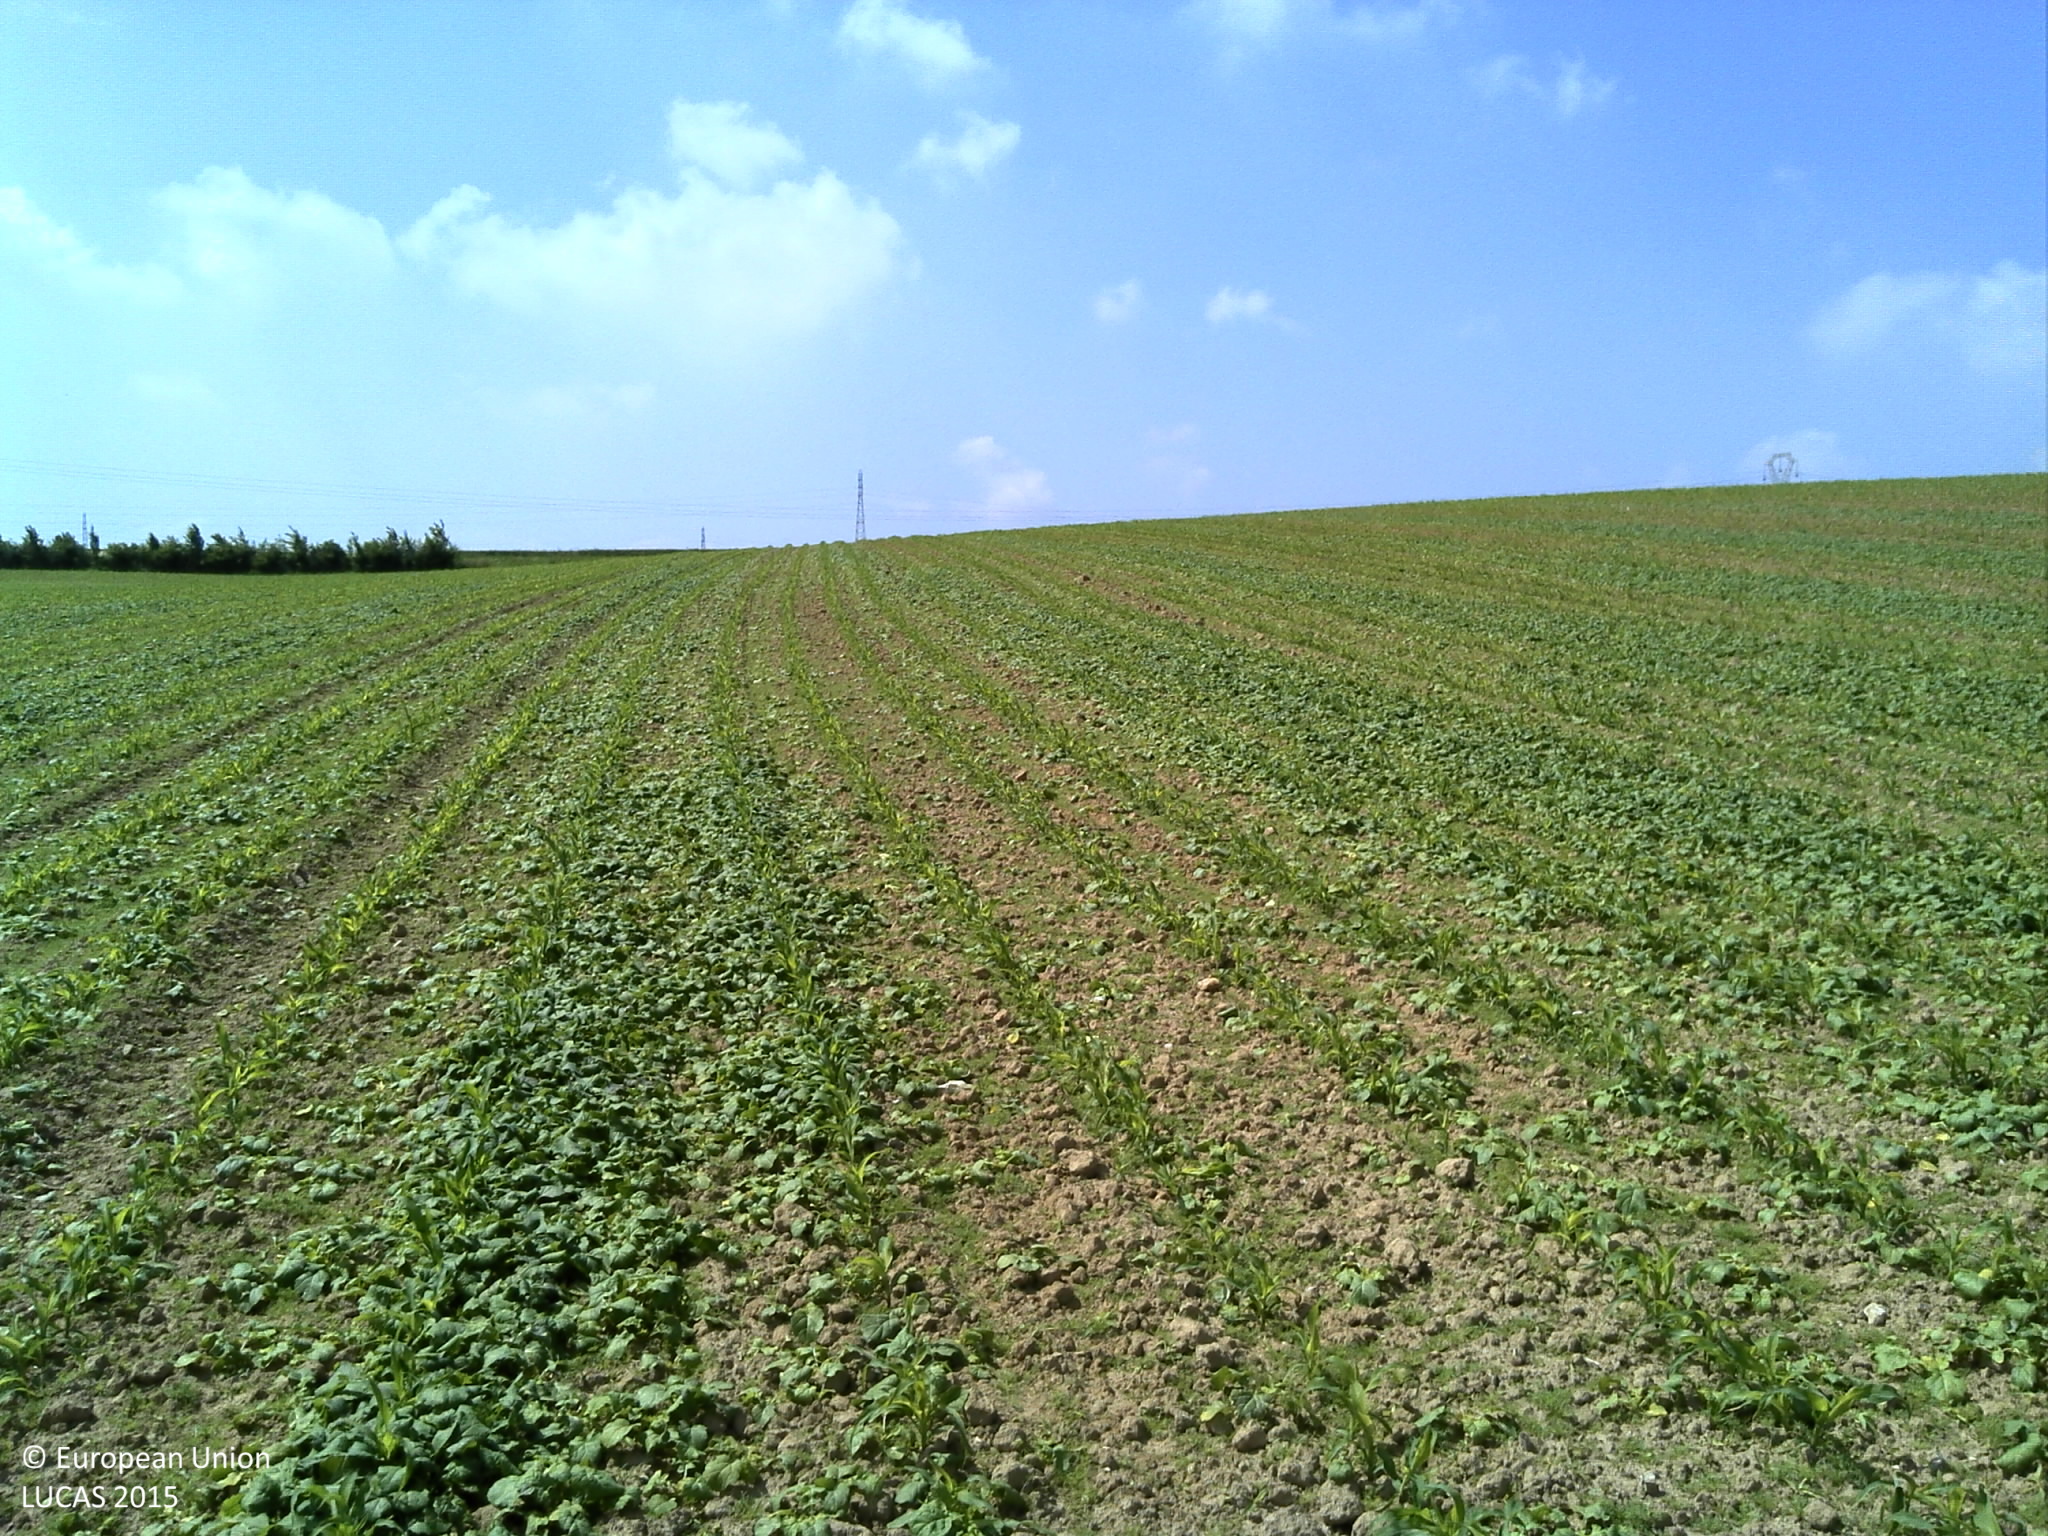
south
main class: Cropland
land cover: Maize
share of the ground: 10 - 25 %
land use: Agriculture (excluding fallow land and kitchen gardens)
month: June
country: FR
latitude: 49.5431
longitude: 0.6181
